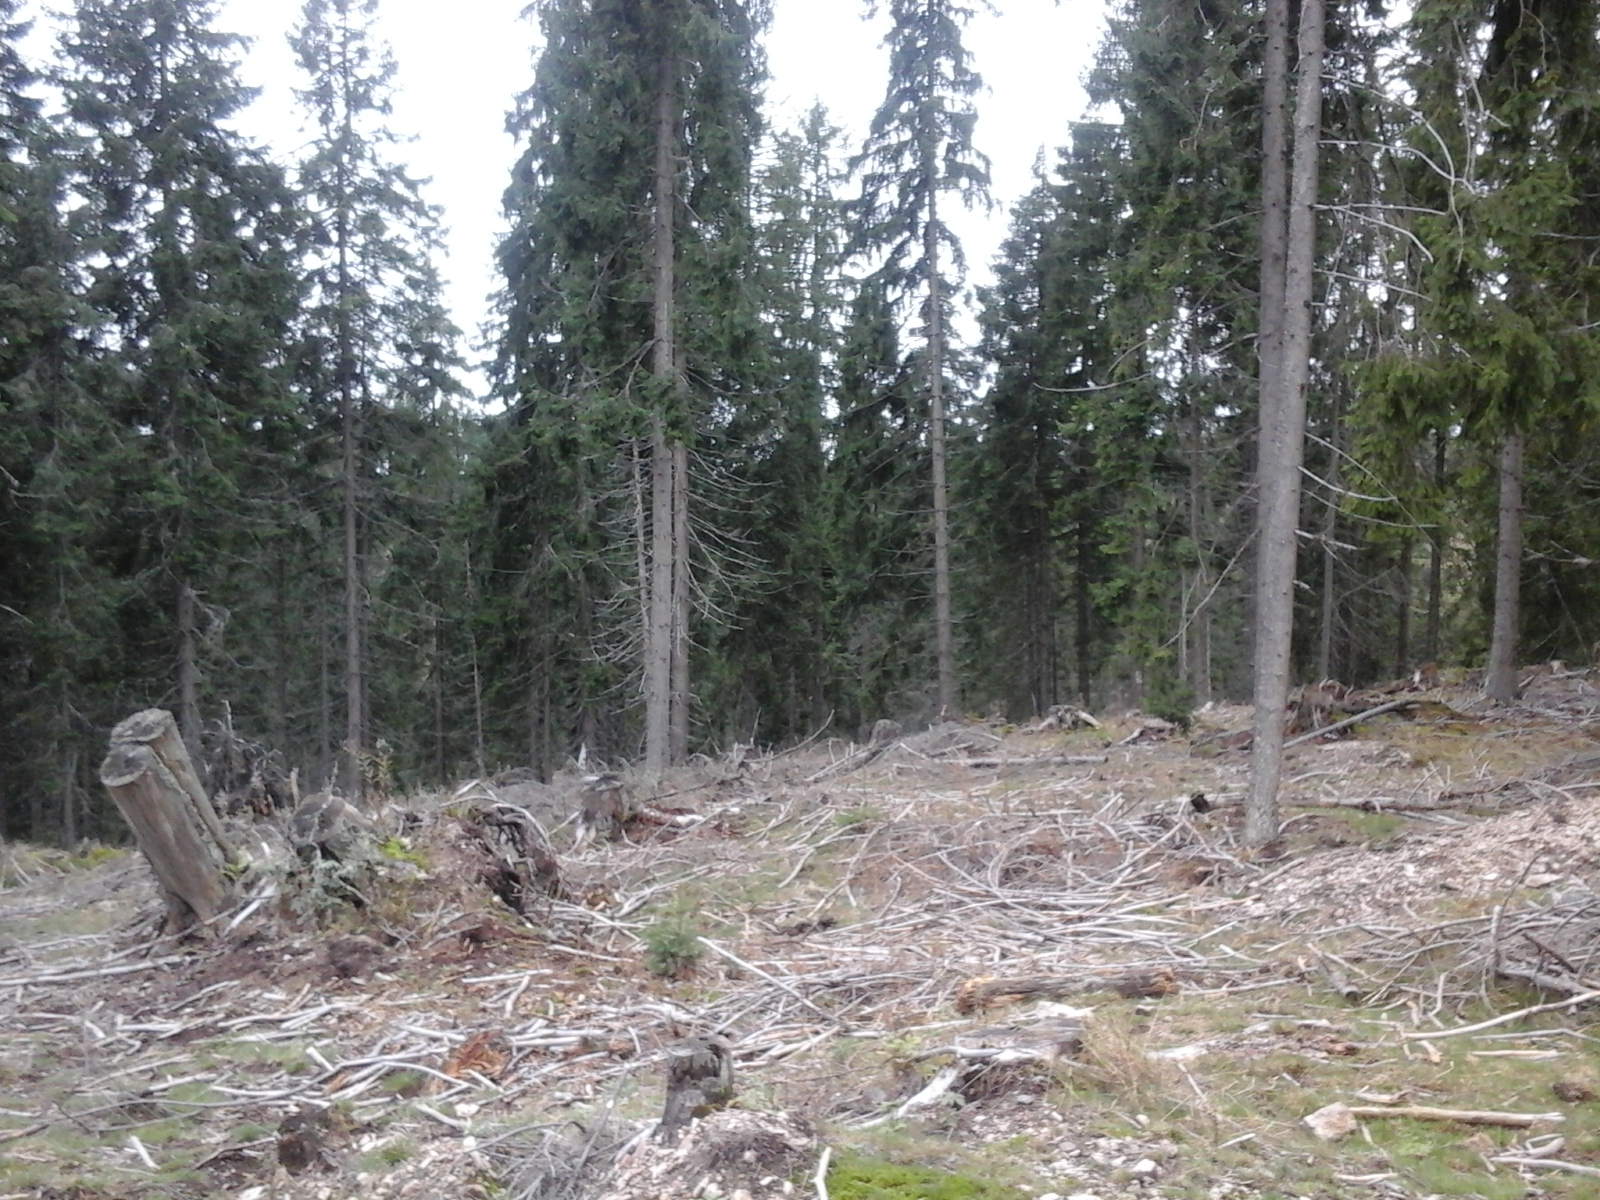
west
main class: Grassland
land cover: Grassland with sparse tree/shrub cover
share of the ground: > 75 %
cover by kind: herbaceous plants 95 %, coniferous forest trees 5 %
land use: Forestry
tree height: > 5 m
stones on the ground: 10 - 25 %
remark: Clear cut
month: September
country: RO
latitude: 46.5386
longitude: 22.8488
